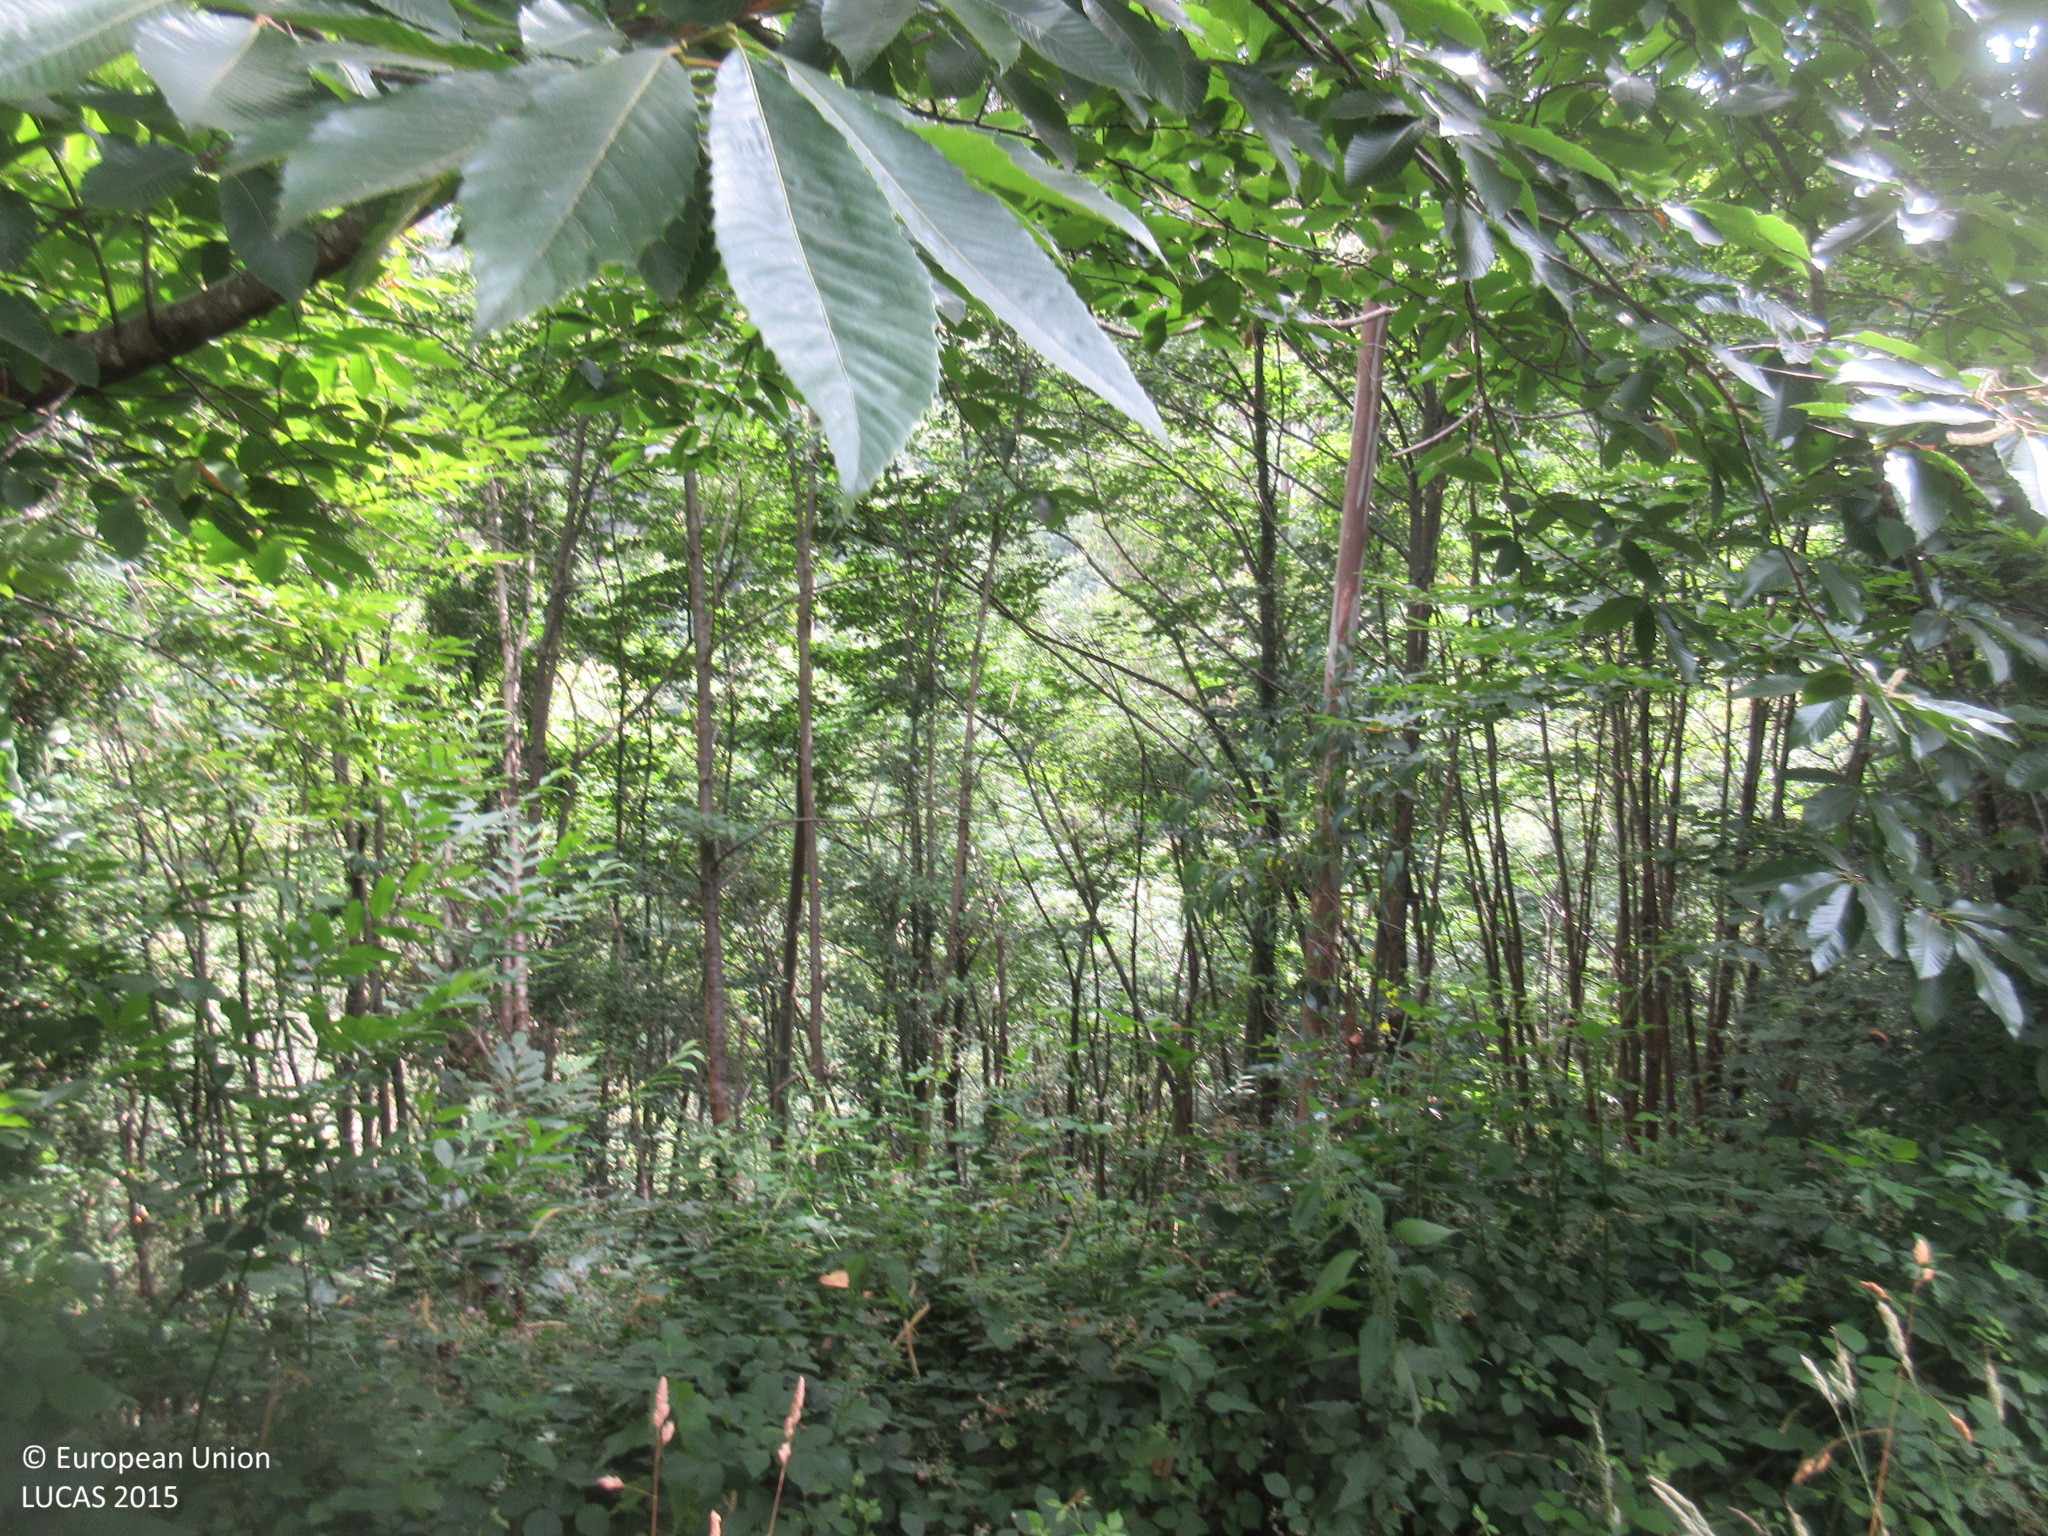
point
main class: Woodland
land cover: Broadleaved woodland
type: thermophilous deciduous forest
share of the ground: > 75 %
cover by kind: broadleaved forest trees 95 %, shrubs 5 %
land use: Forestry
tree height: > 5 m
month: July
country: ES
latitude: 43.4474
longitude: -6.3495
